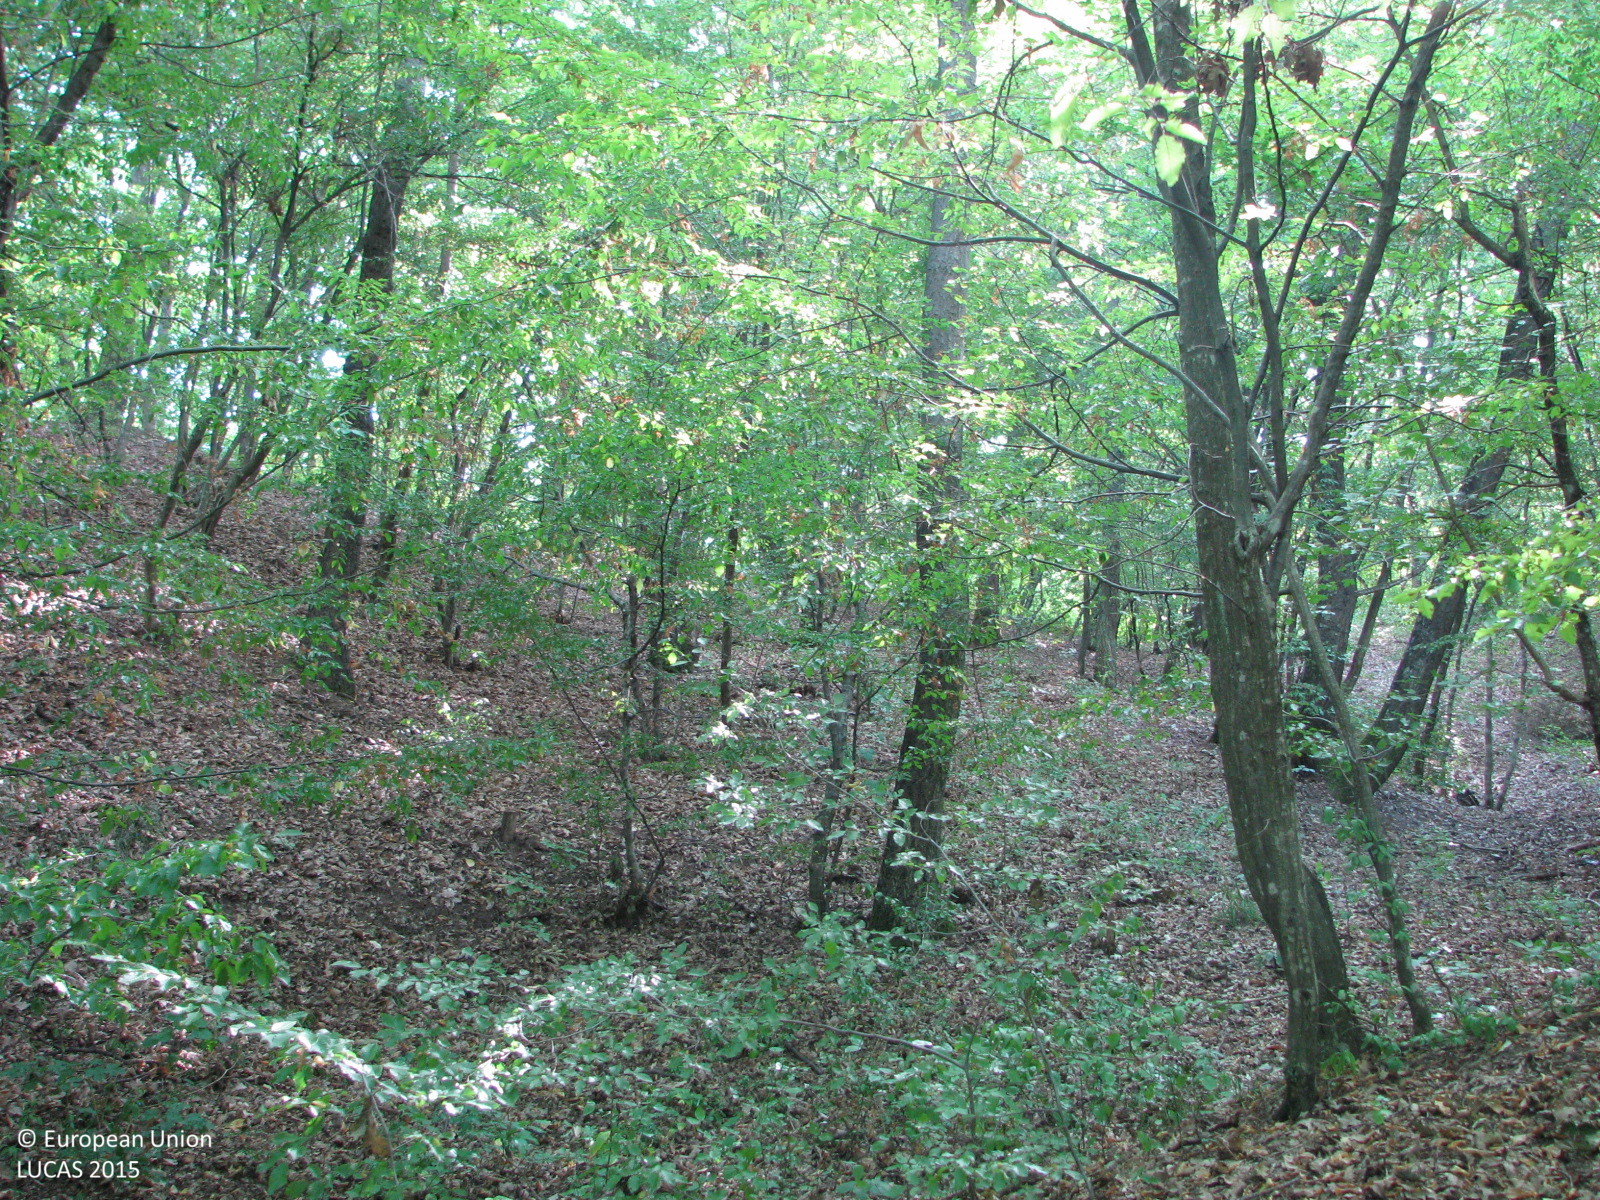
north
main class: Woodland
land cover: Broadleaved woodland
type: beech forest
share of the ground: > 75 %
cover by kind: broadleaved forest trees 75 %, consolidated bare surface 25 %
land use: Forestry
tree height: > 5 m
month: August
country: BG
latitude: 42.7075
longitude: 26.2663
